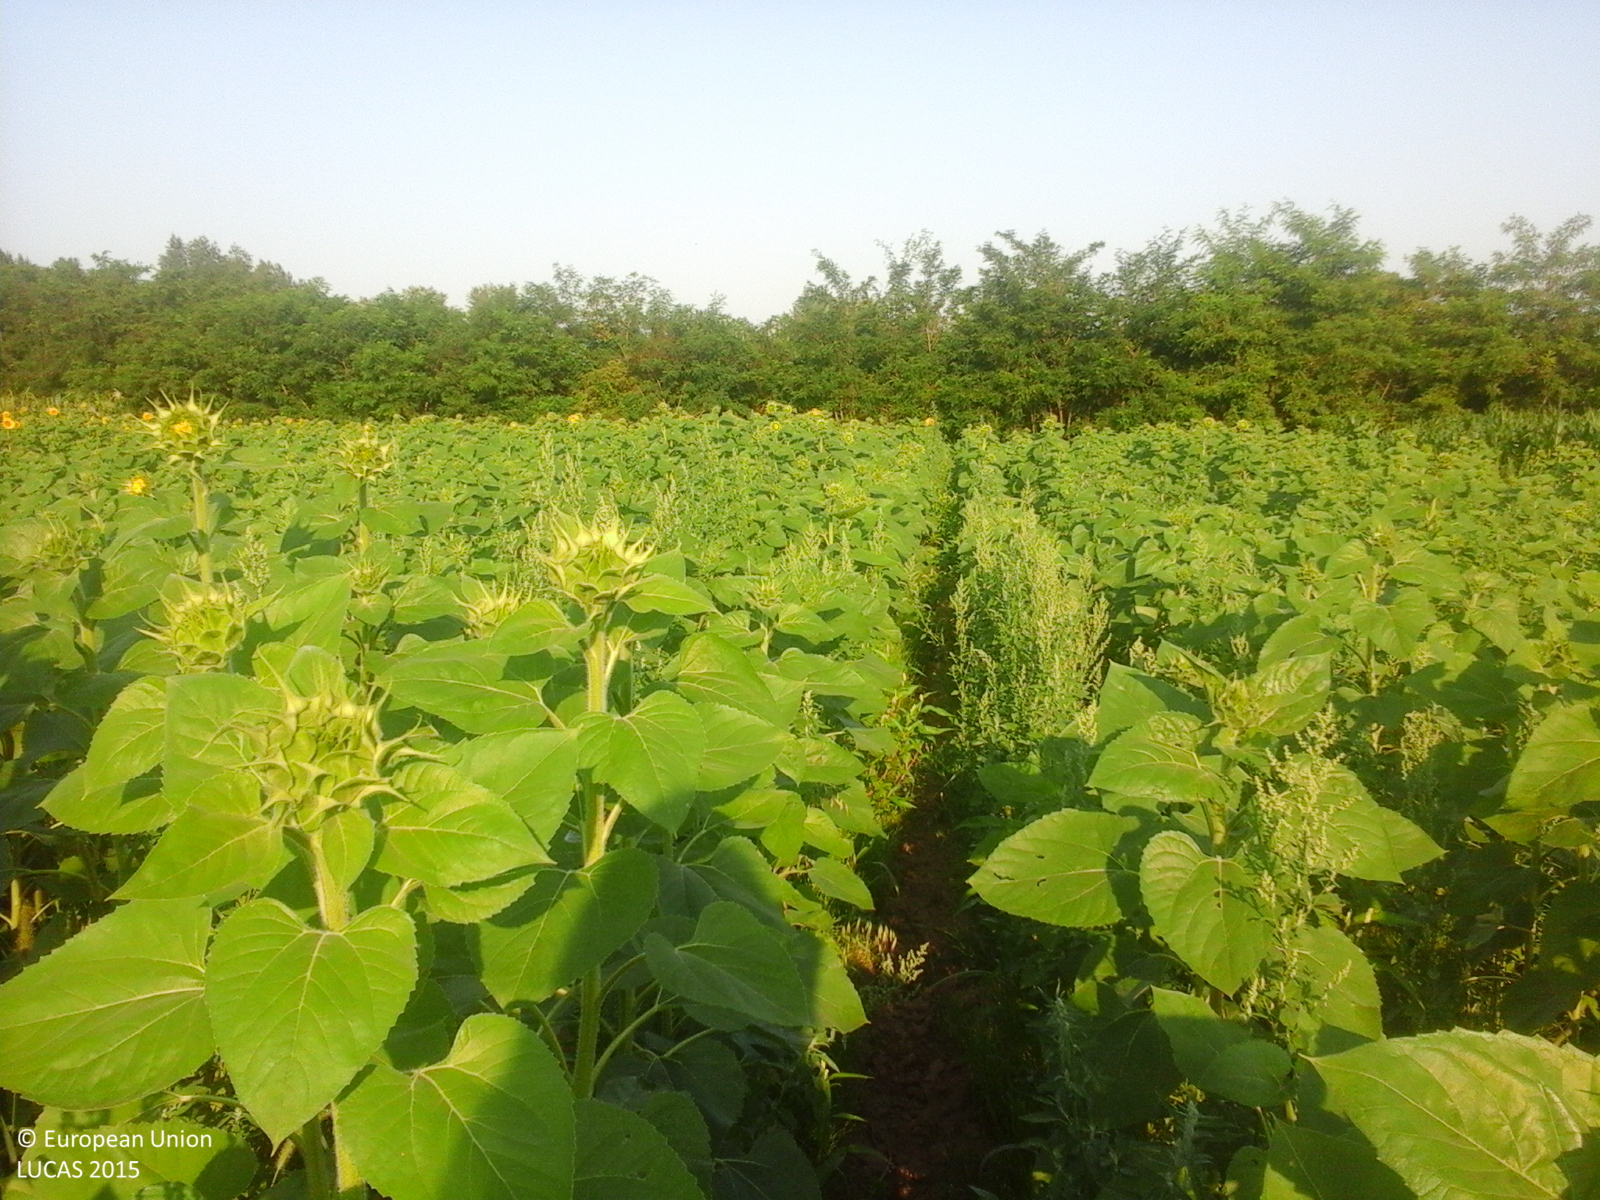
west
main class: Cropland
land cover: Sunflower
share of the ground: > 75 %
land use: Agriculture (excluding fallow land and kitchen gardens)
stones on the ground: < 10 %
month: July
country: RO
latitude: 44.4836
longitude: 24.7233
